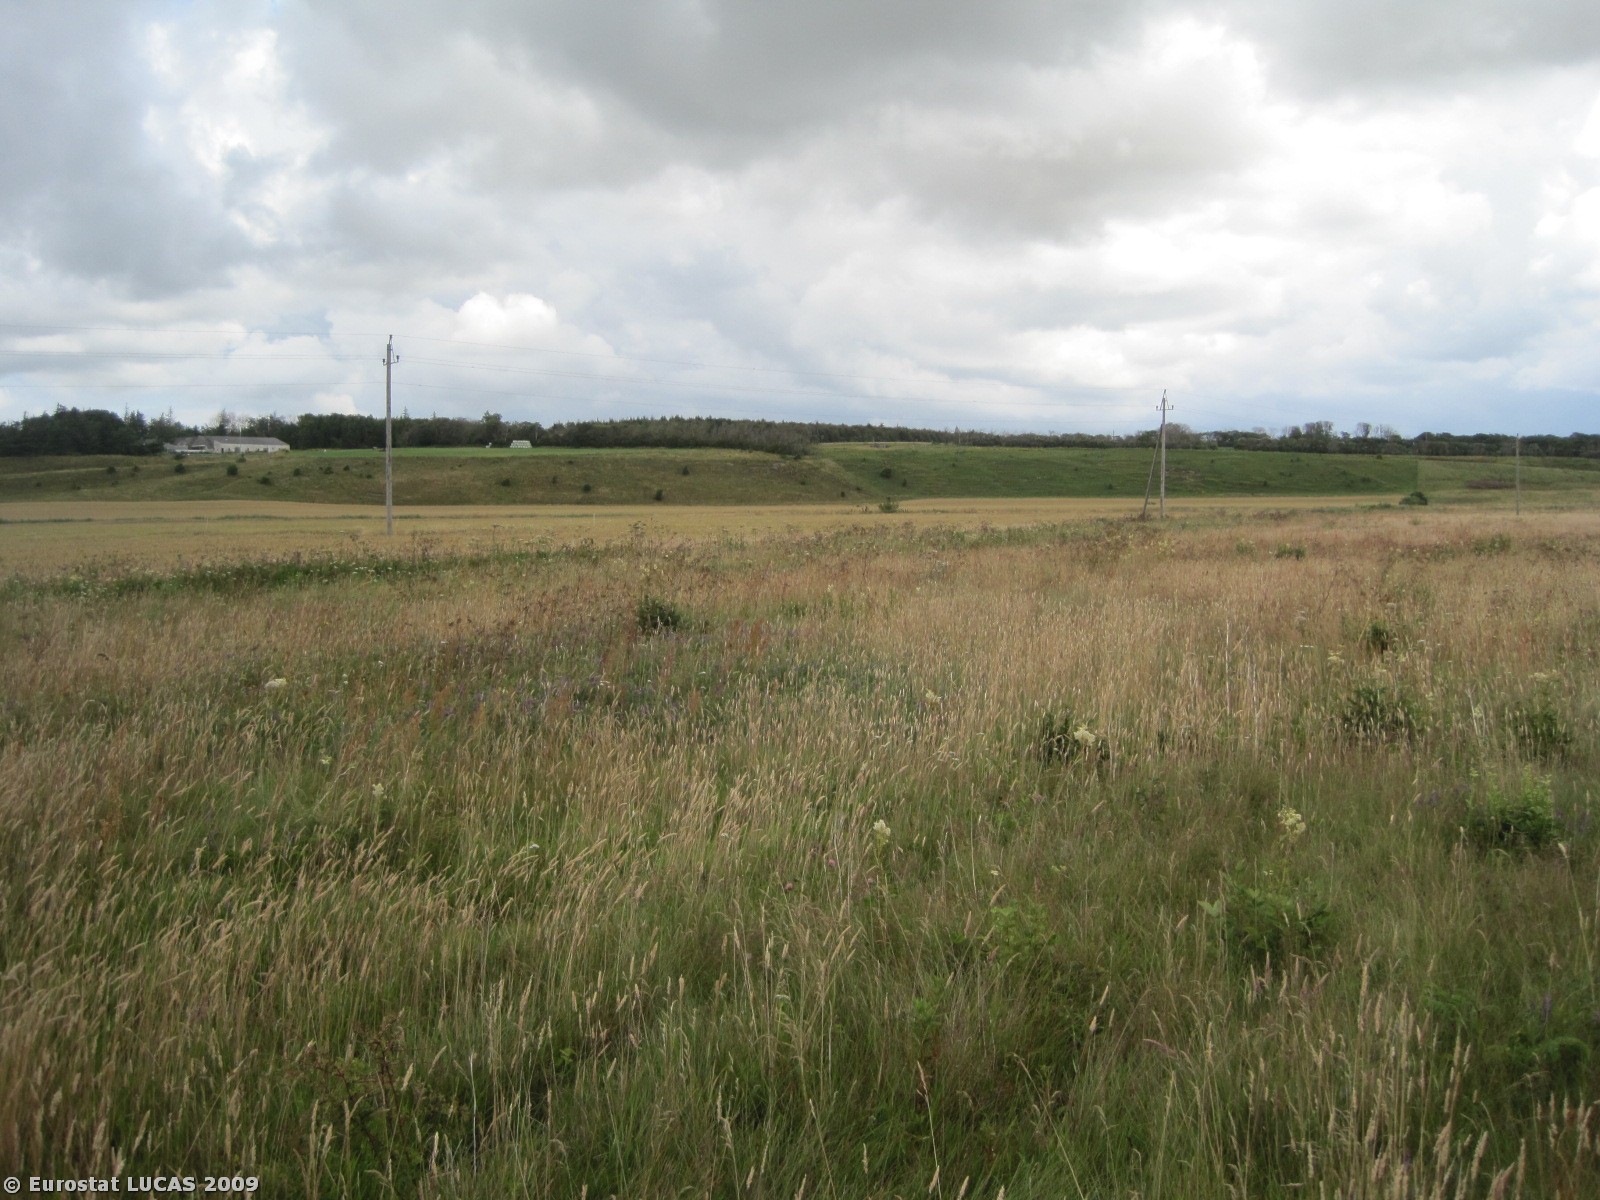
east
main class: Grassland
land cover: Grassland without tree/shrub cover
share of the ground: > 75 %
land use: Unused
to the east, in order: Grassland without tree/shrub cover; Ditches and canals; Common wheat; Electric lines; Common wheat; Grassland without tree/shrub cover; Inland running water; Grassland without tree/shrub cover; Rye
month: July
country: DK
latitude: 57.0628
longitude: 8.7651
